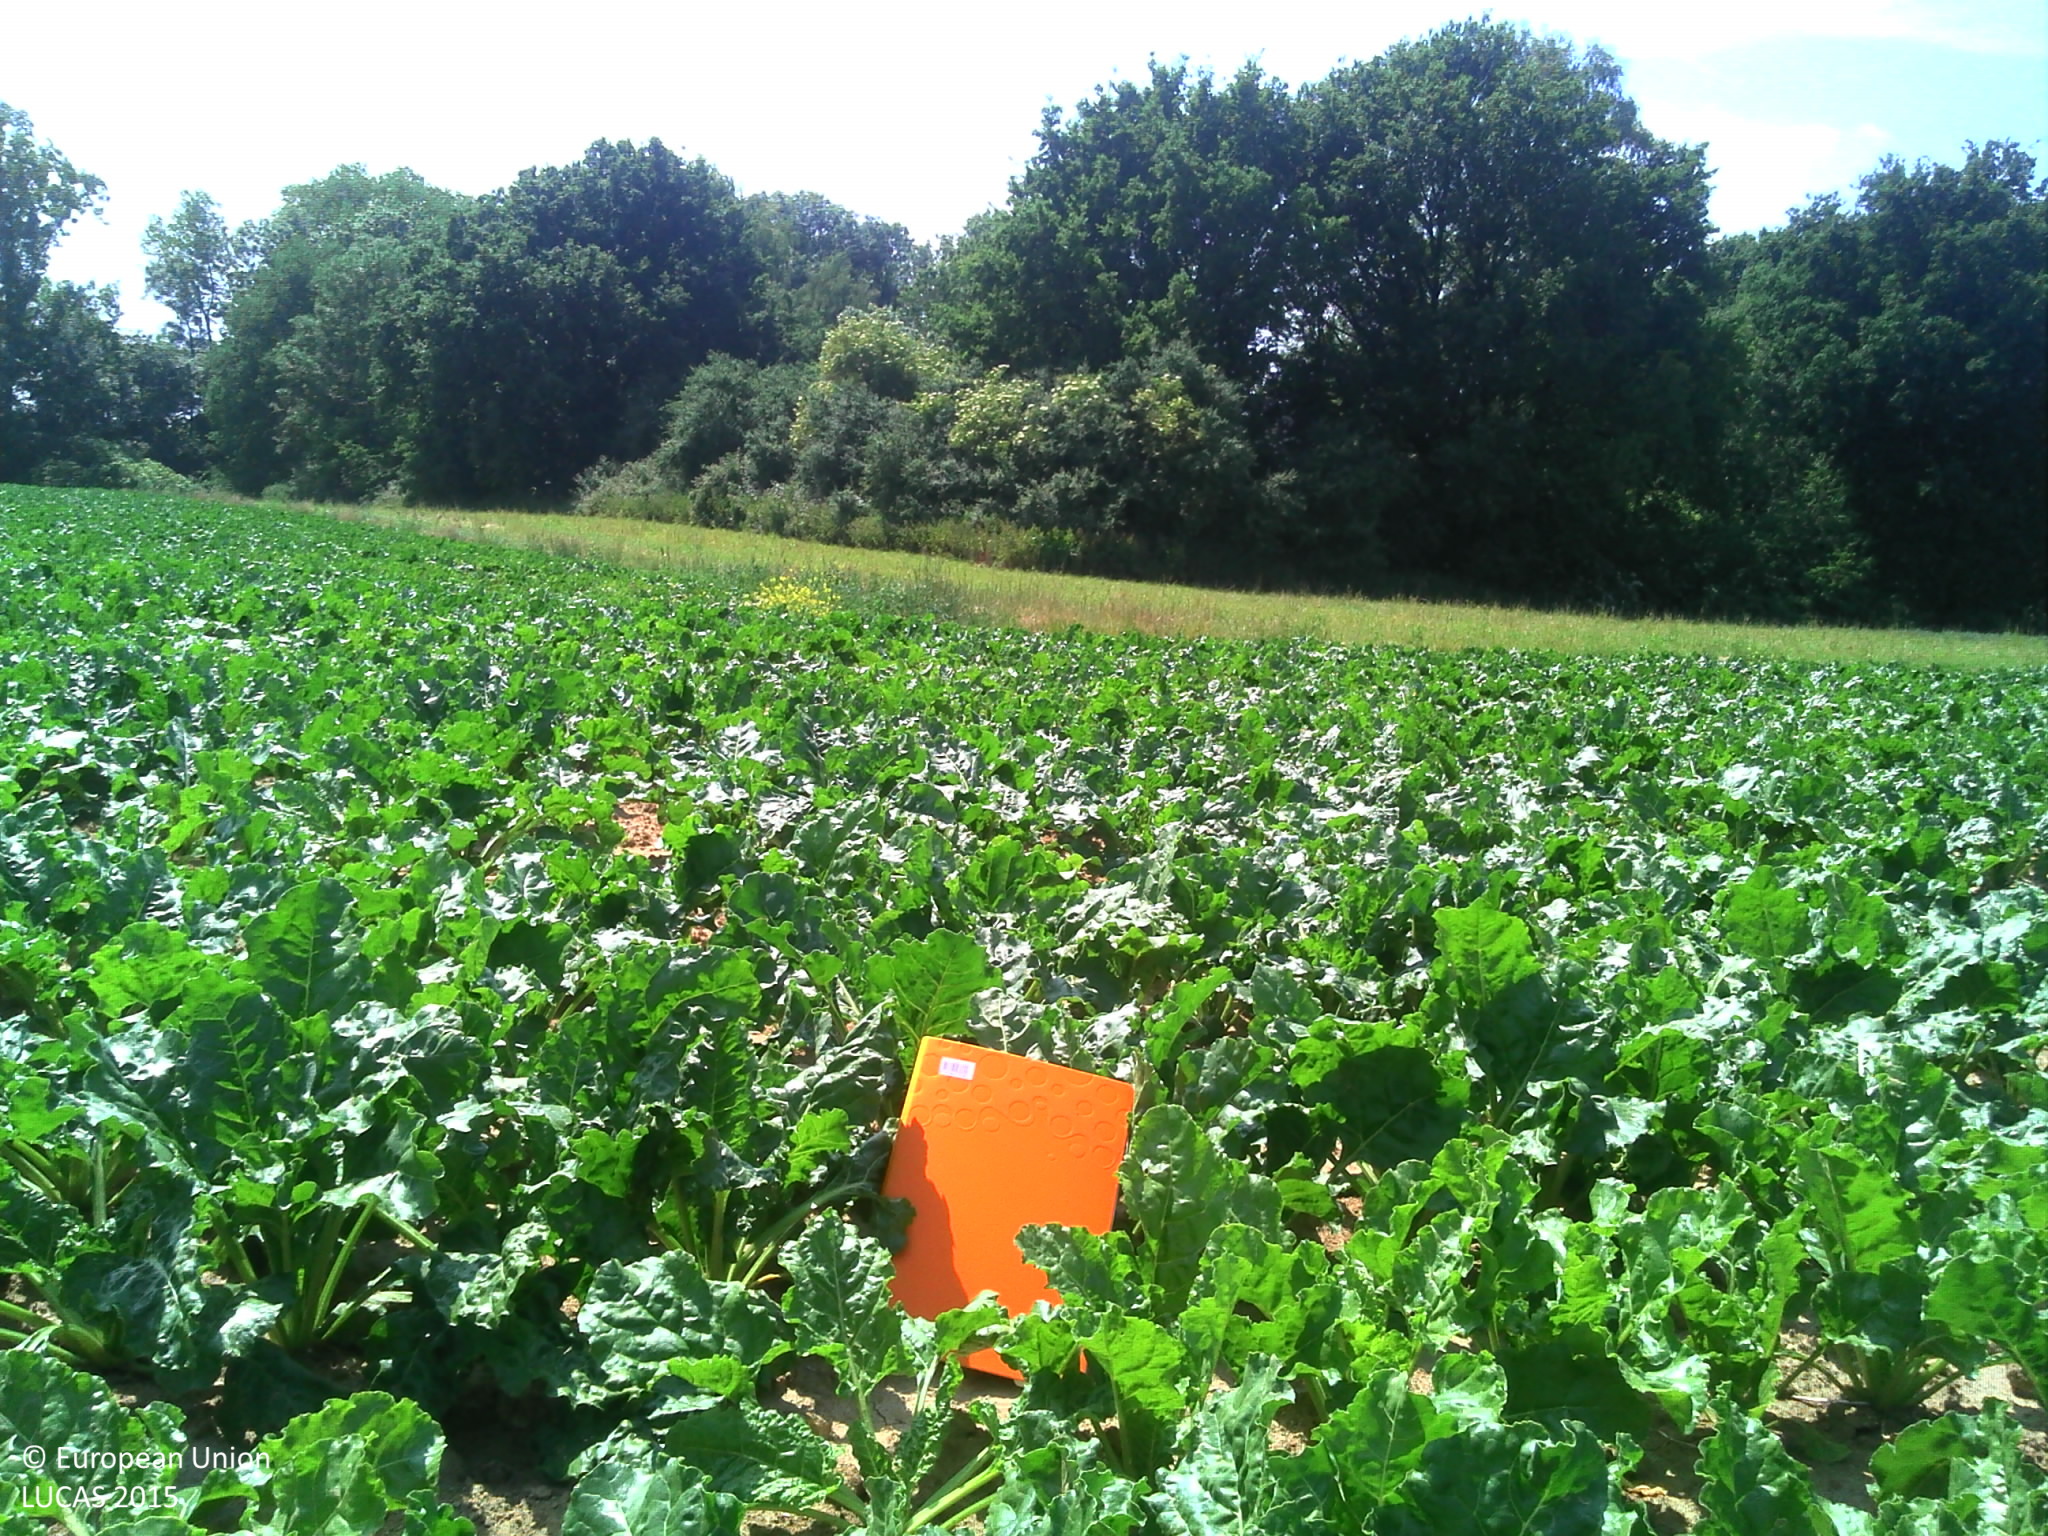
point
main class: Cropland
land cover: Sugar beet
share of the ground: > 75 %
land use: Agriculture (excluding fallow land and kitchen gardens)
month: June
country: BE
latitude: 50.7755
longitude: 4.5646
